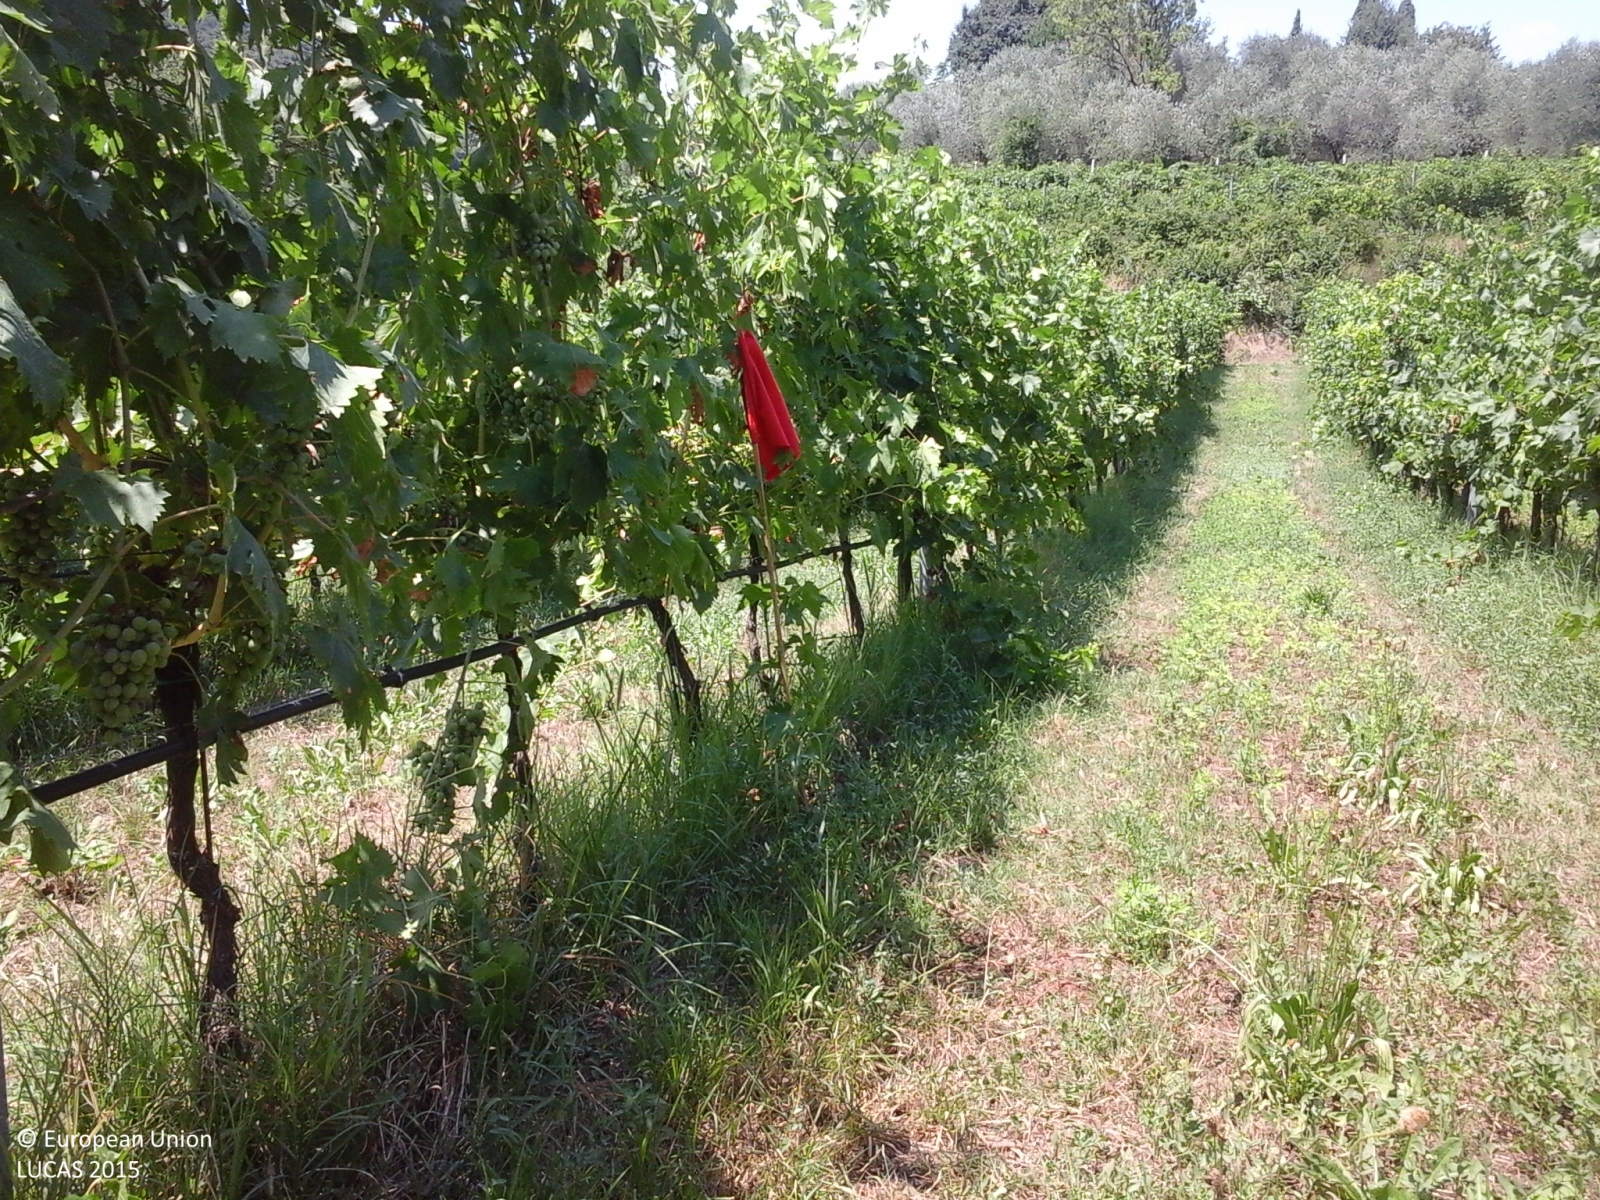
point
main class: Cropland
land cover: Vineyards
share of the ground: 25 - 50 %
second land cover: Grassland without tree/shrub cover
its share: > 75 %
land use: Agriculture (excluding fallow land and kitchen gardens)
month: July
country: IT
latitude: 45.4625
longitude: 11.1108
